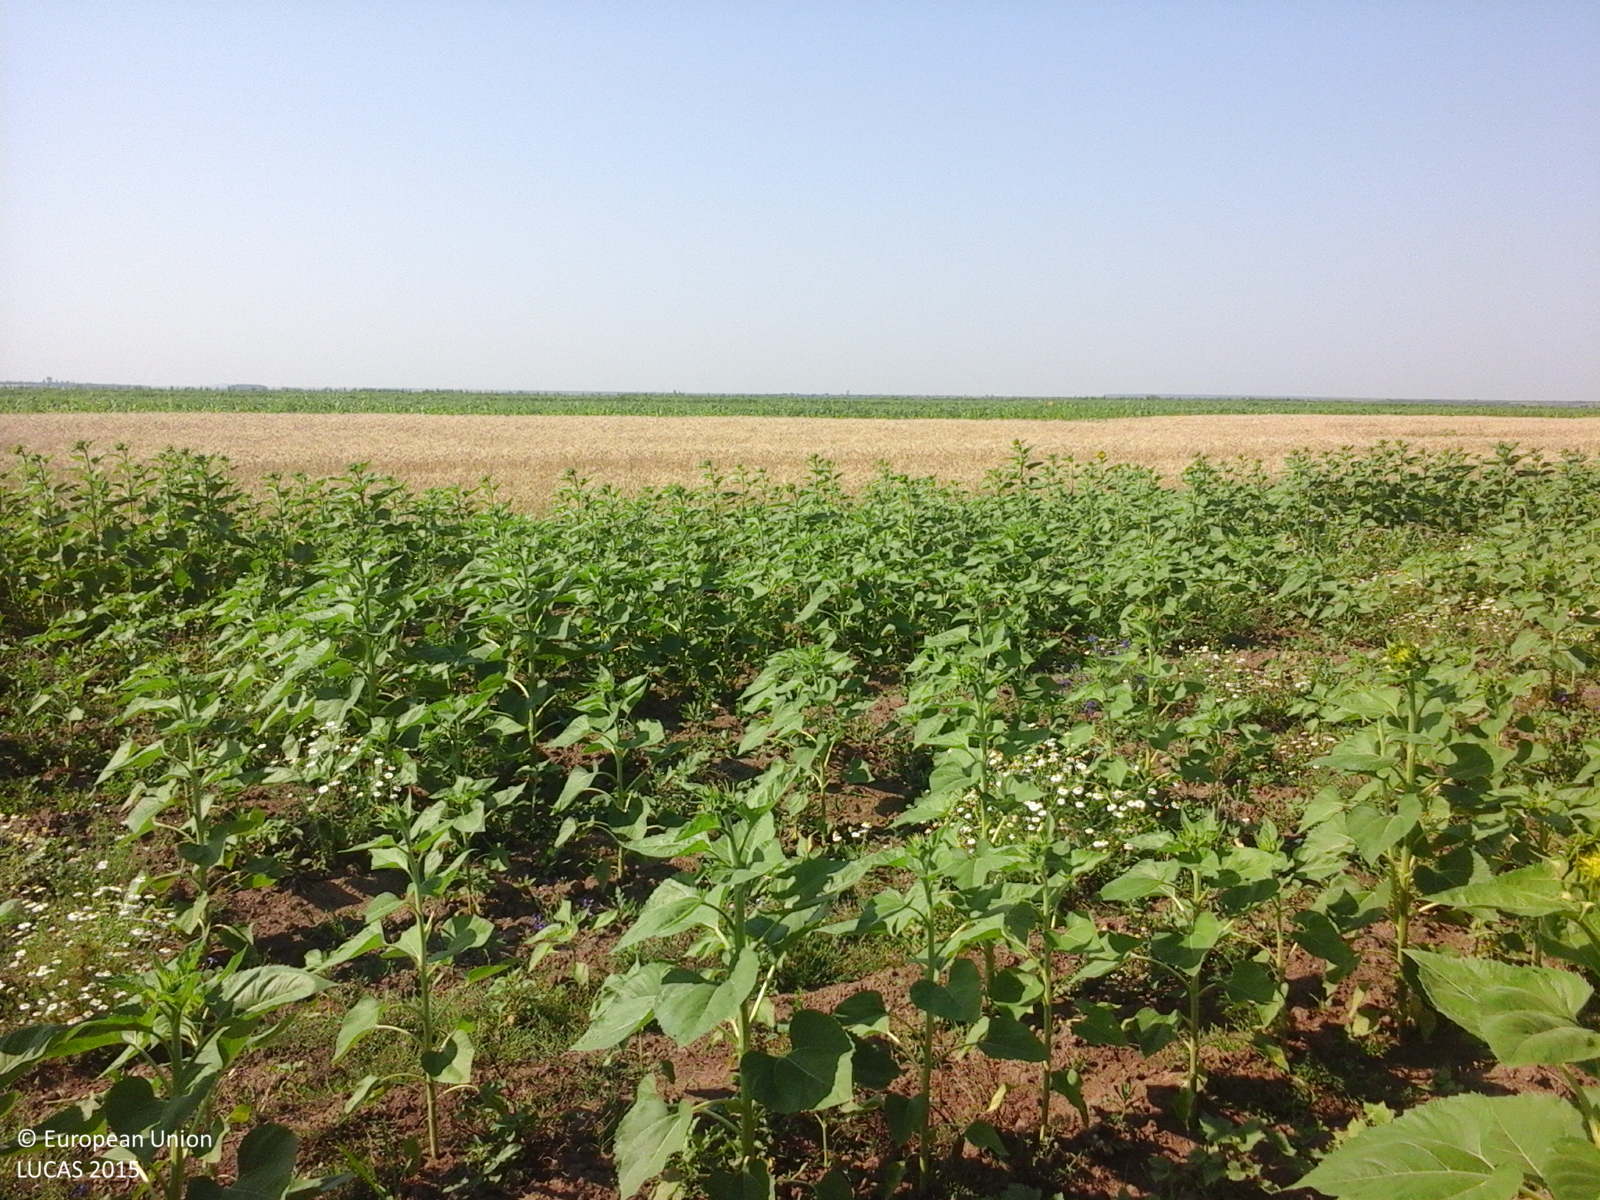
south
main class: Cropland
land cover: Sunflower
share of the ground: > 75 %
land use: Agriculture (excluding fallow land and kitchen gardens)
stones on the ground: < 10 %
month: July
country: RO
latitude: 44.1571
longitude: 25.3269
